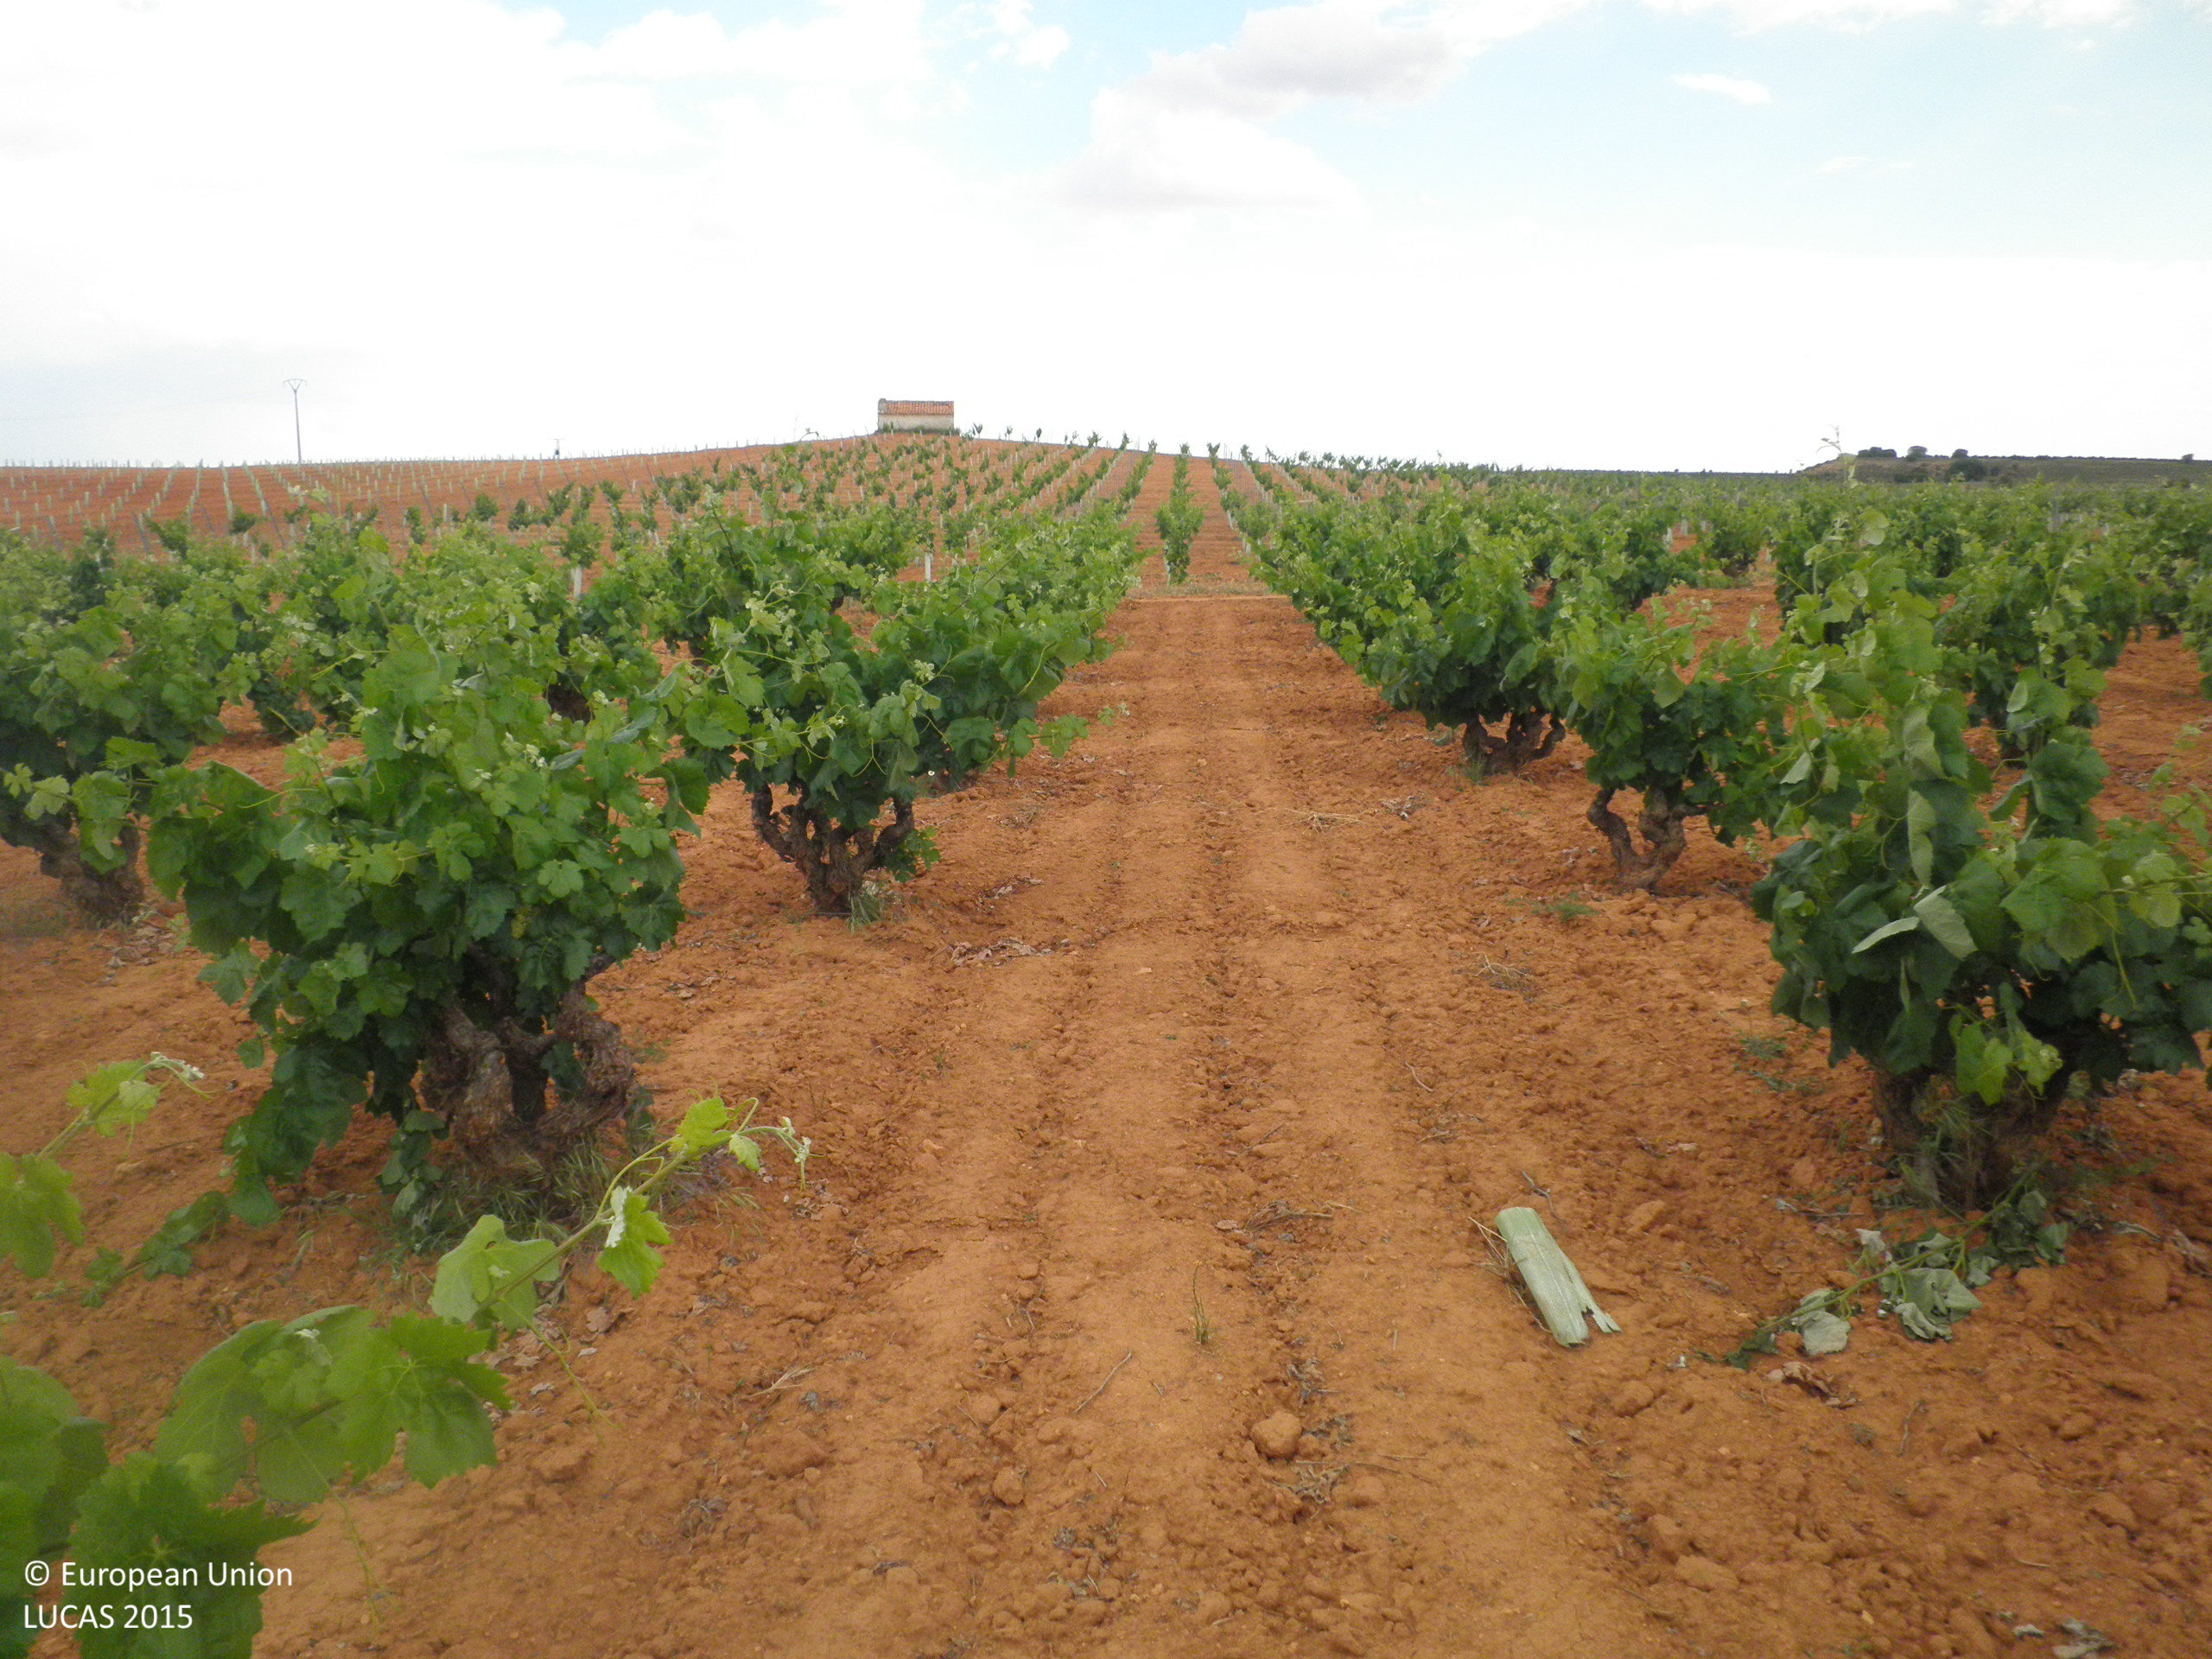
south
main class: Cropland
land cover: Vineyards
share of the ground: 10 - 25 %
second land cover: Other bare soil
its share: > 75 %
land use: Agriculture (excluding fallow land and kitchen gardens)
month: June
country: ES
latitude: 39.4430
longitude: -1.7993
